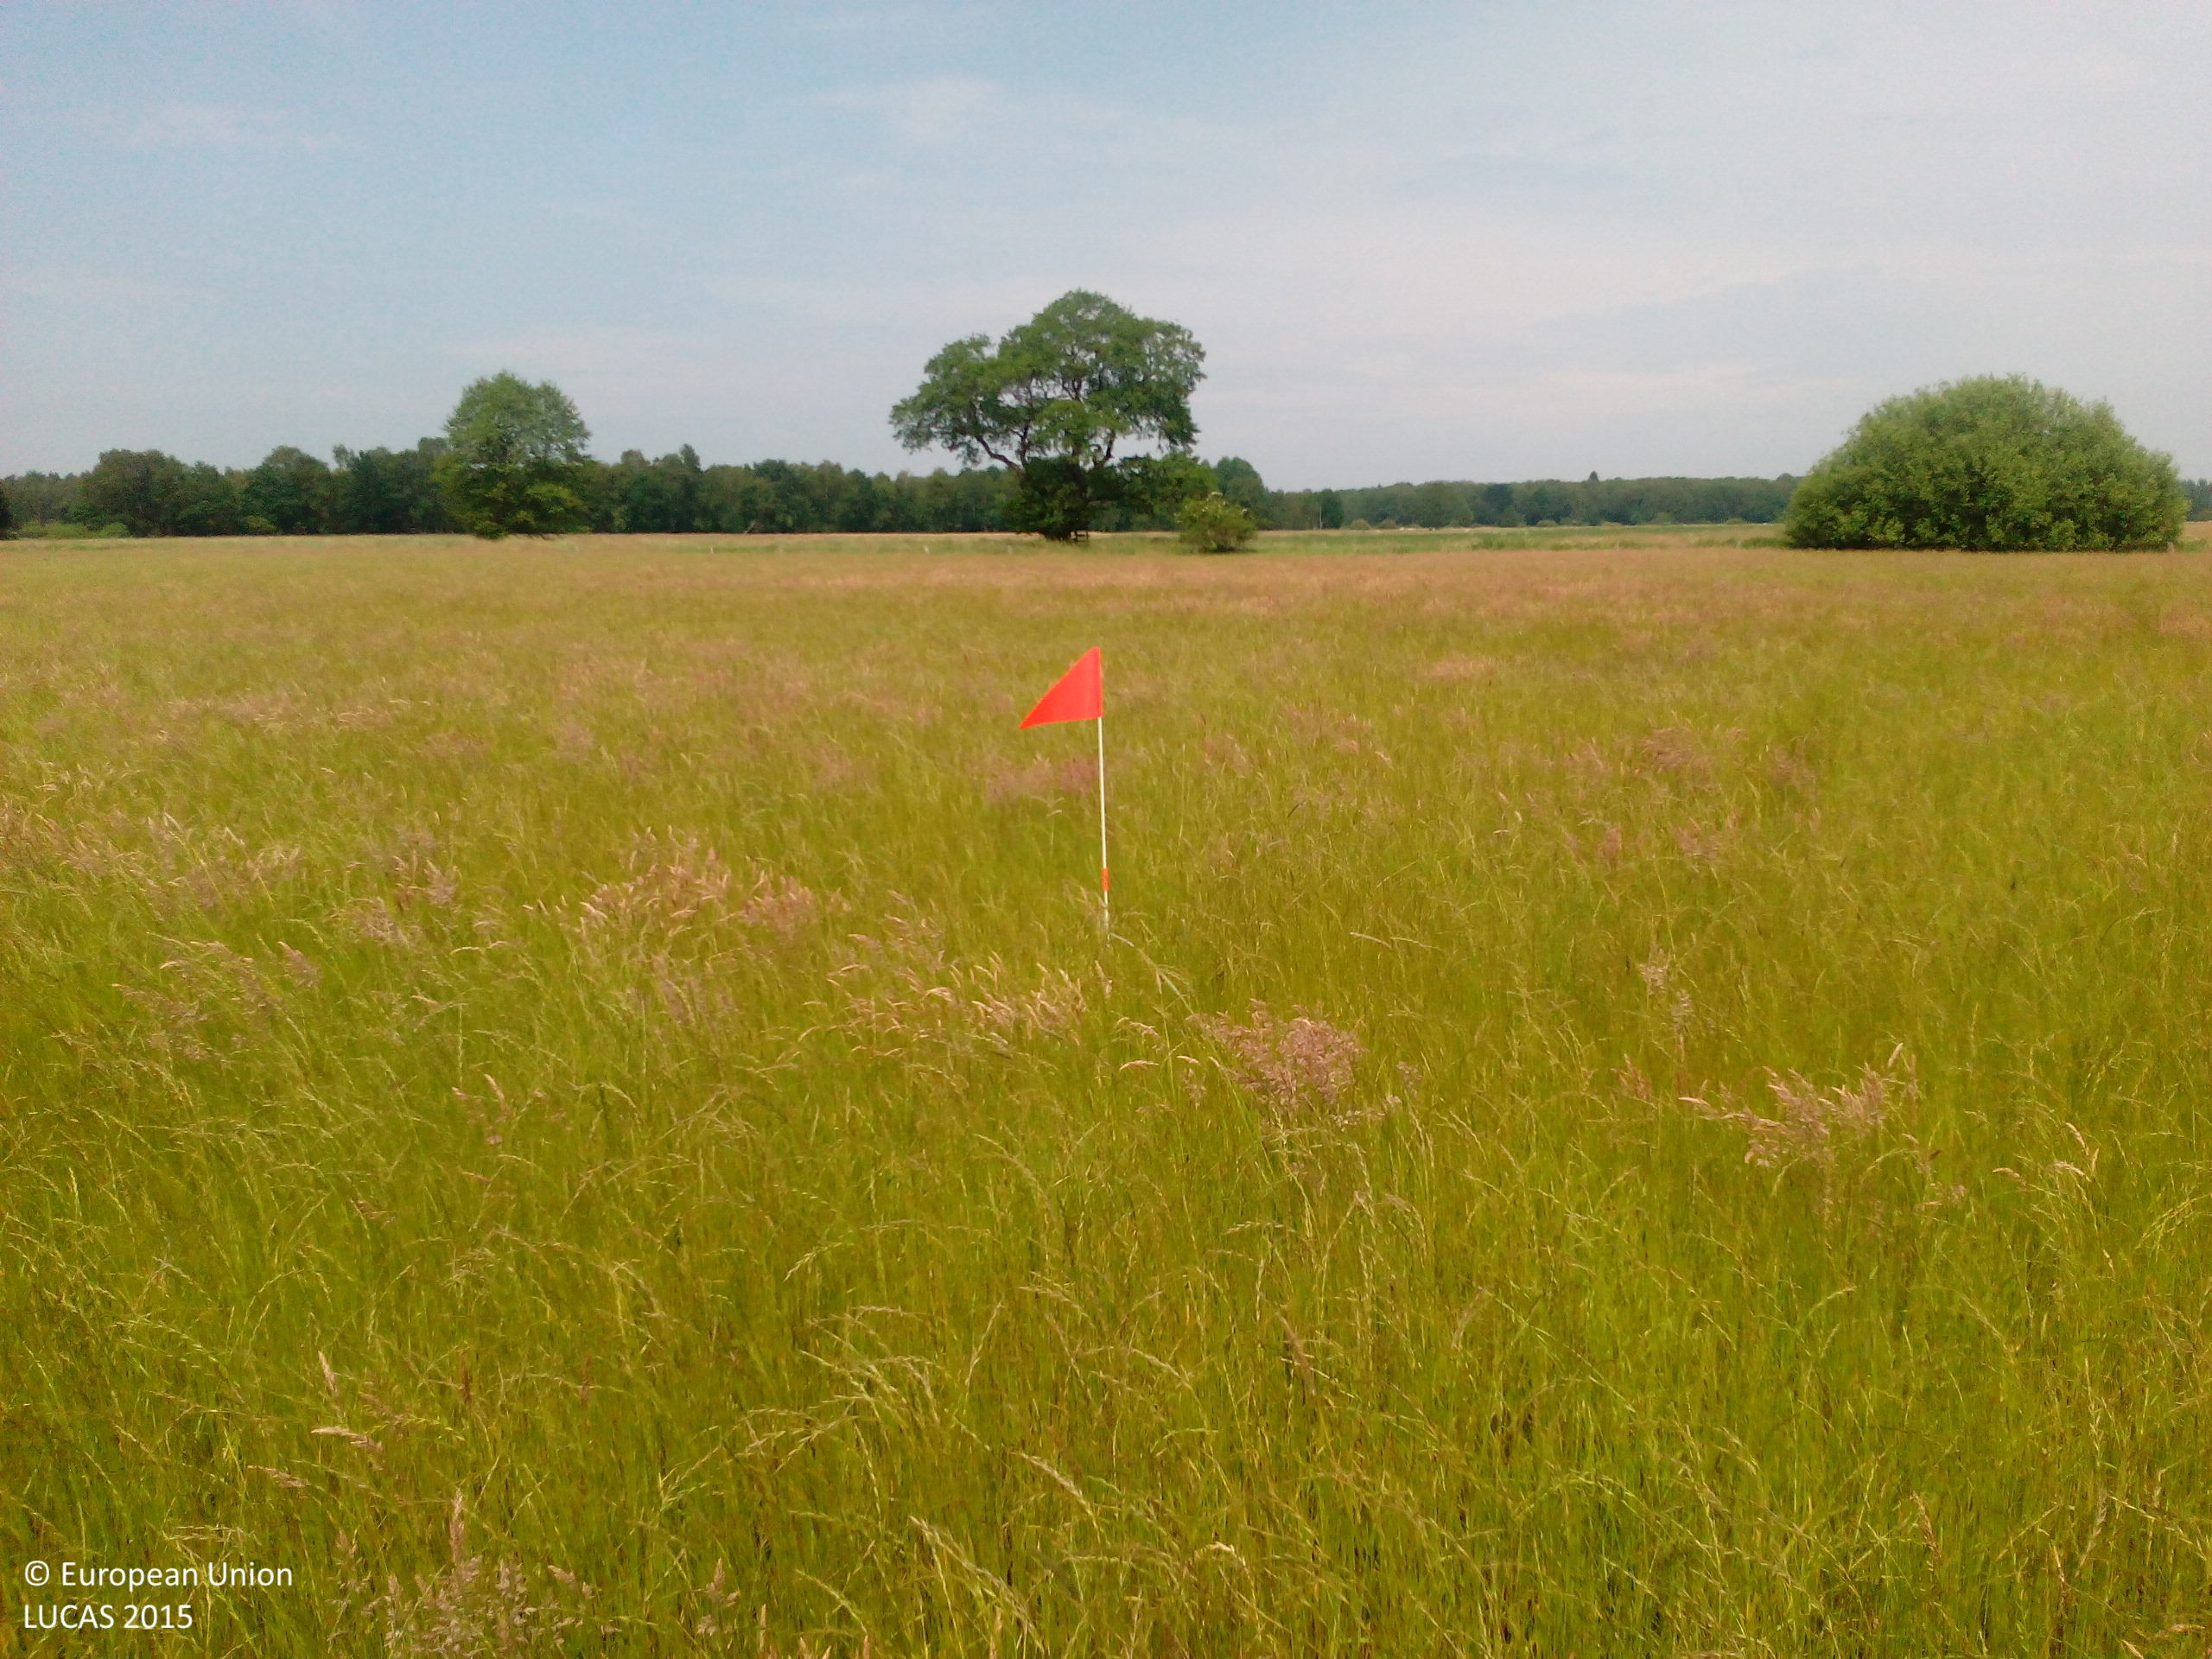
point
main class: Grassland
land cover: Grassland without tree/shrub cover
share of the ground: > 75 %
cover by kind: herbaceous plants 100 %
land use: Agriculture (excluding fallow land and kitchen gardens)
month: June
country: DE
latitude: 52.5558
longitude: 10.5750
